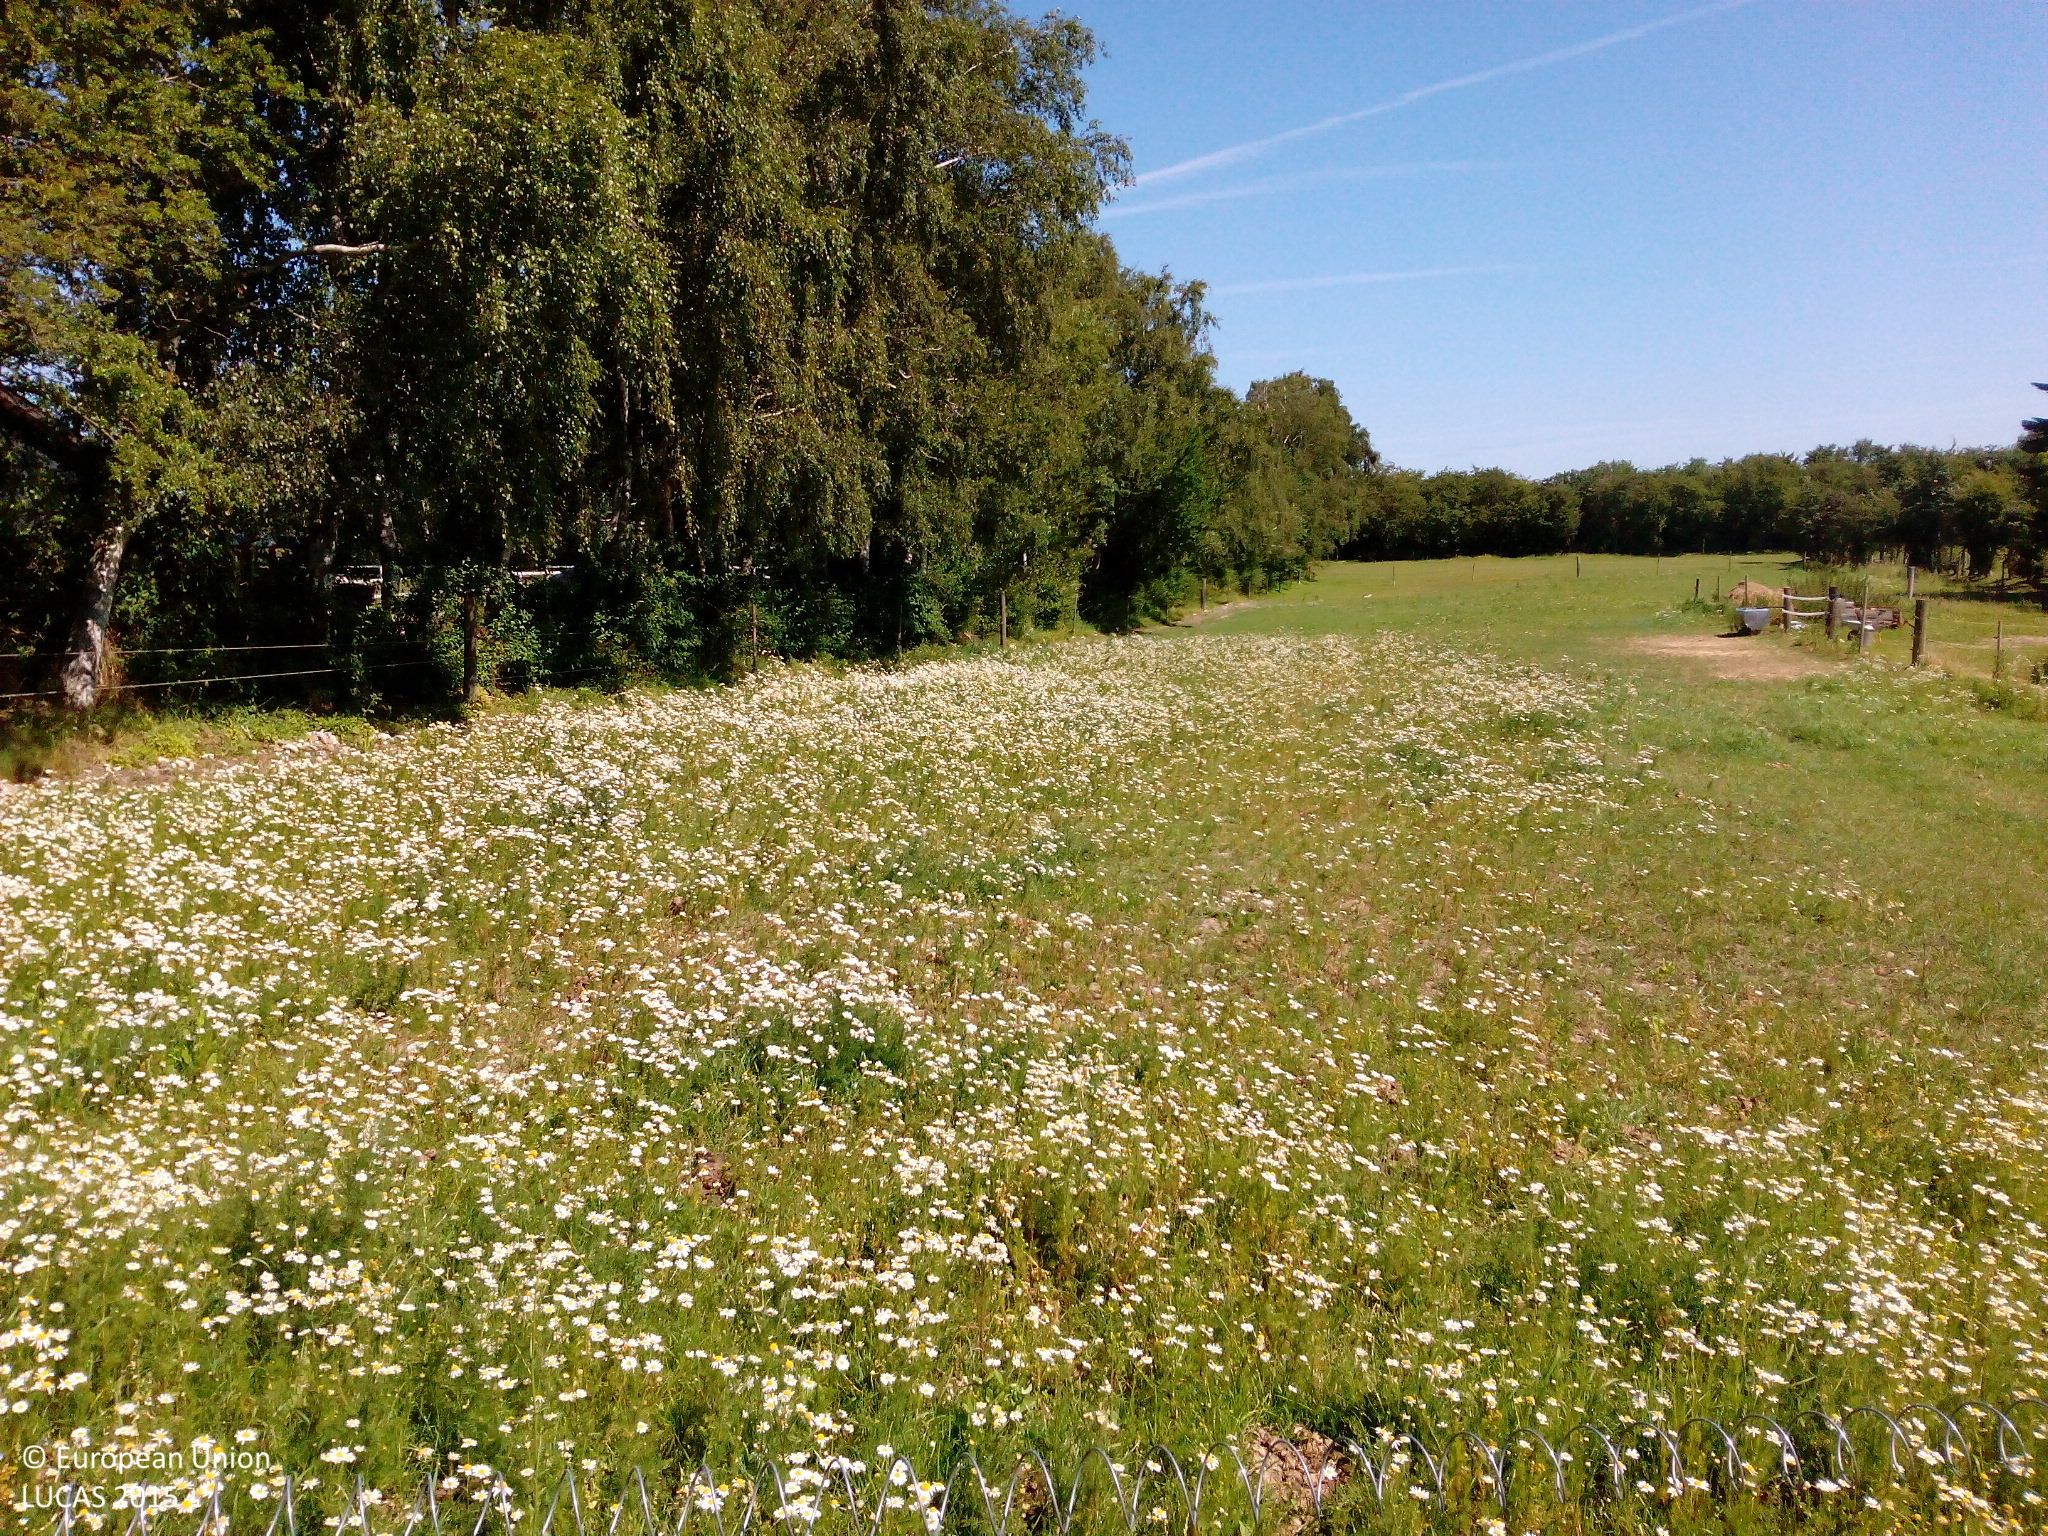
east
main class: Grassland
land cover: Grassland without tree/shrub cover
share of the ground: > 75 %
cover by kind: herbaceous plants 100 %
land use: Agriculture (excluding fallow land and kitchen gardens)
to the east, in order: Grassland without tree/shrub cover; Fences; Broadleaved woodland; Tracks; Broadleaved woodland; Fences; Grassland without tree/shrub cover; Fences; Broadleaved woodland; Fences; Grassland without tree/shrub cover; Fences; Broadleaved woodland; Fences; Grassland without tree/shrub cover
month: July
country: DK
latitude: 55.4763
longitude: 11.6282
